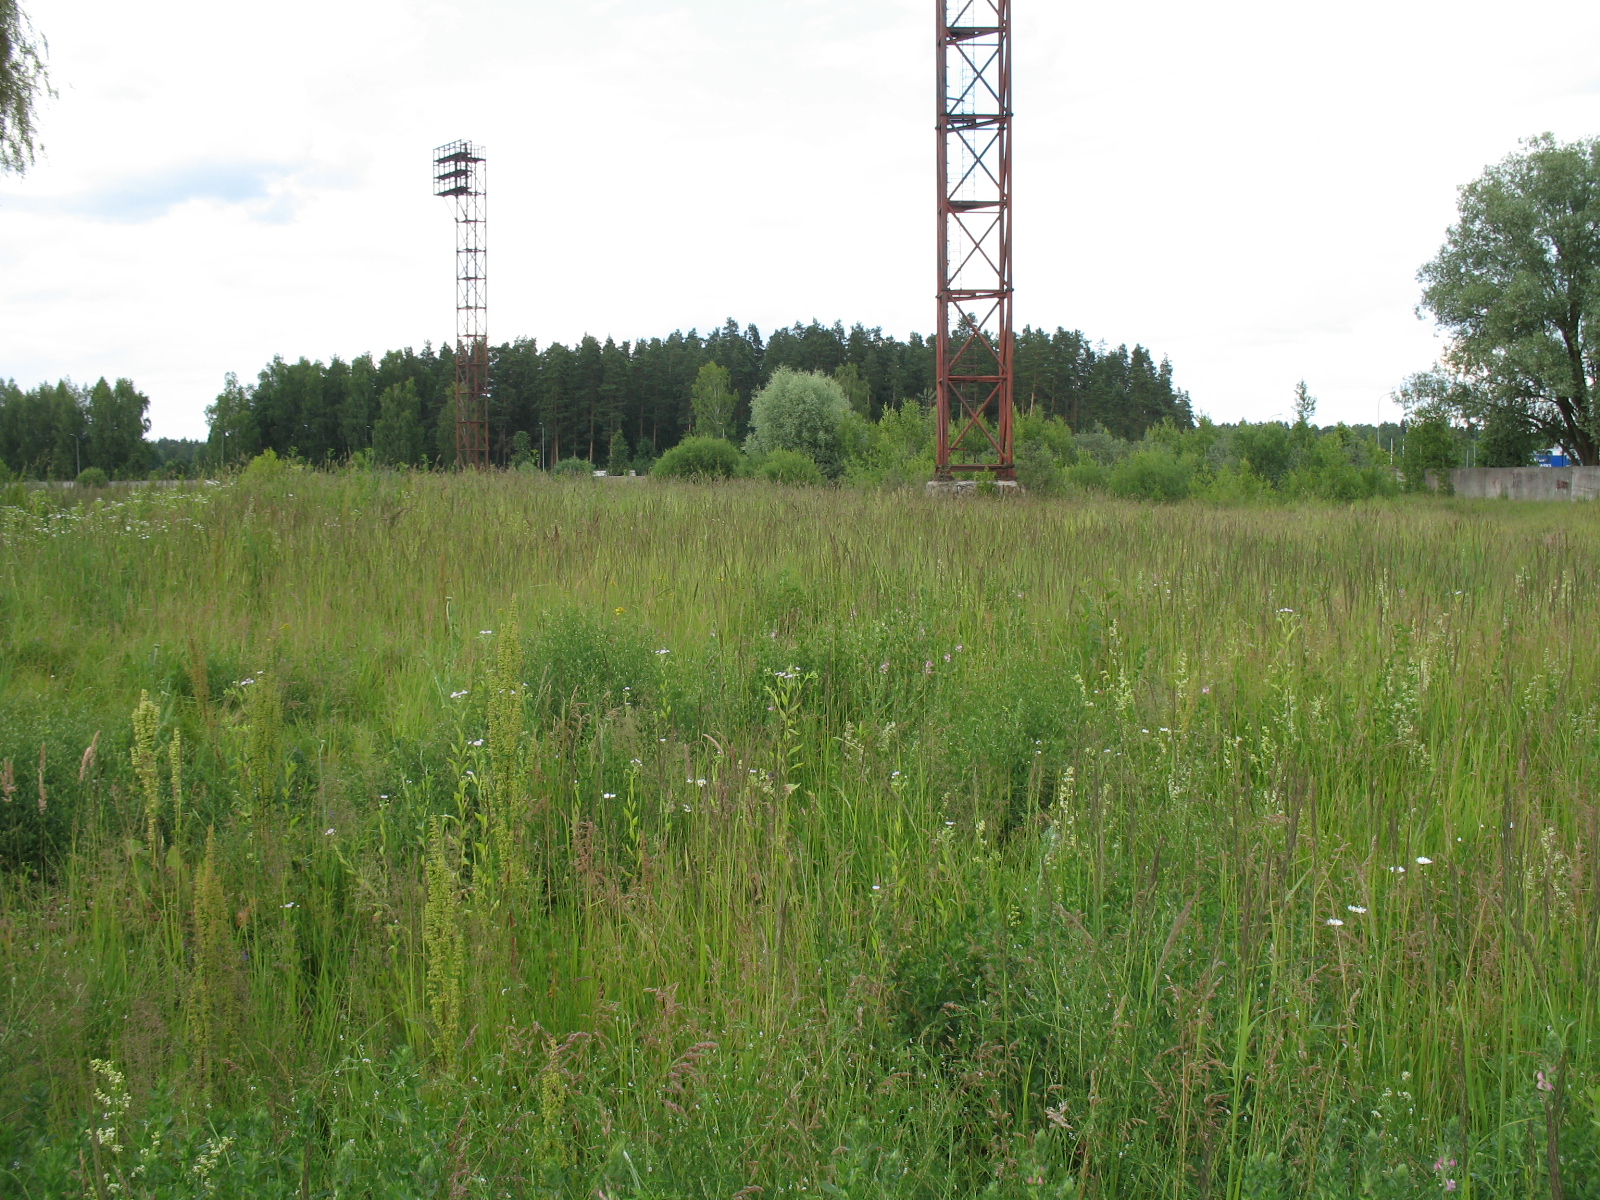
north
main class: Grassland
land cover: Grassland without tree/shrub cover
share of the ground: > 75 %
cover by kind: herbaceous plants 100 %
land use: Abandoned areas
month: June
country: LV
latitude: 56.6650
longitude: 23.7690
